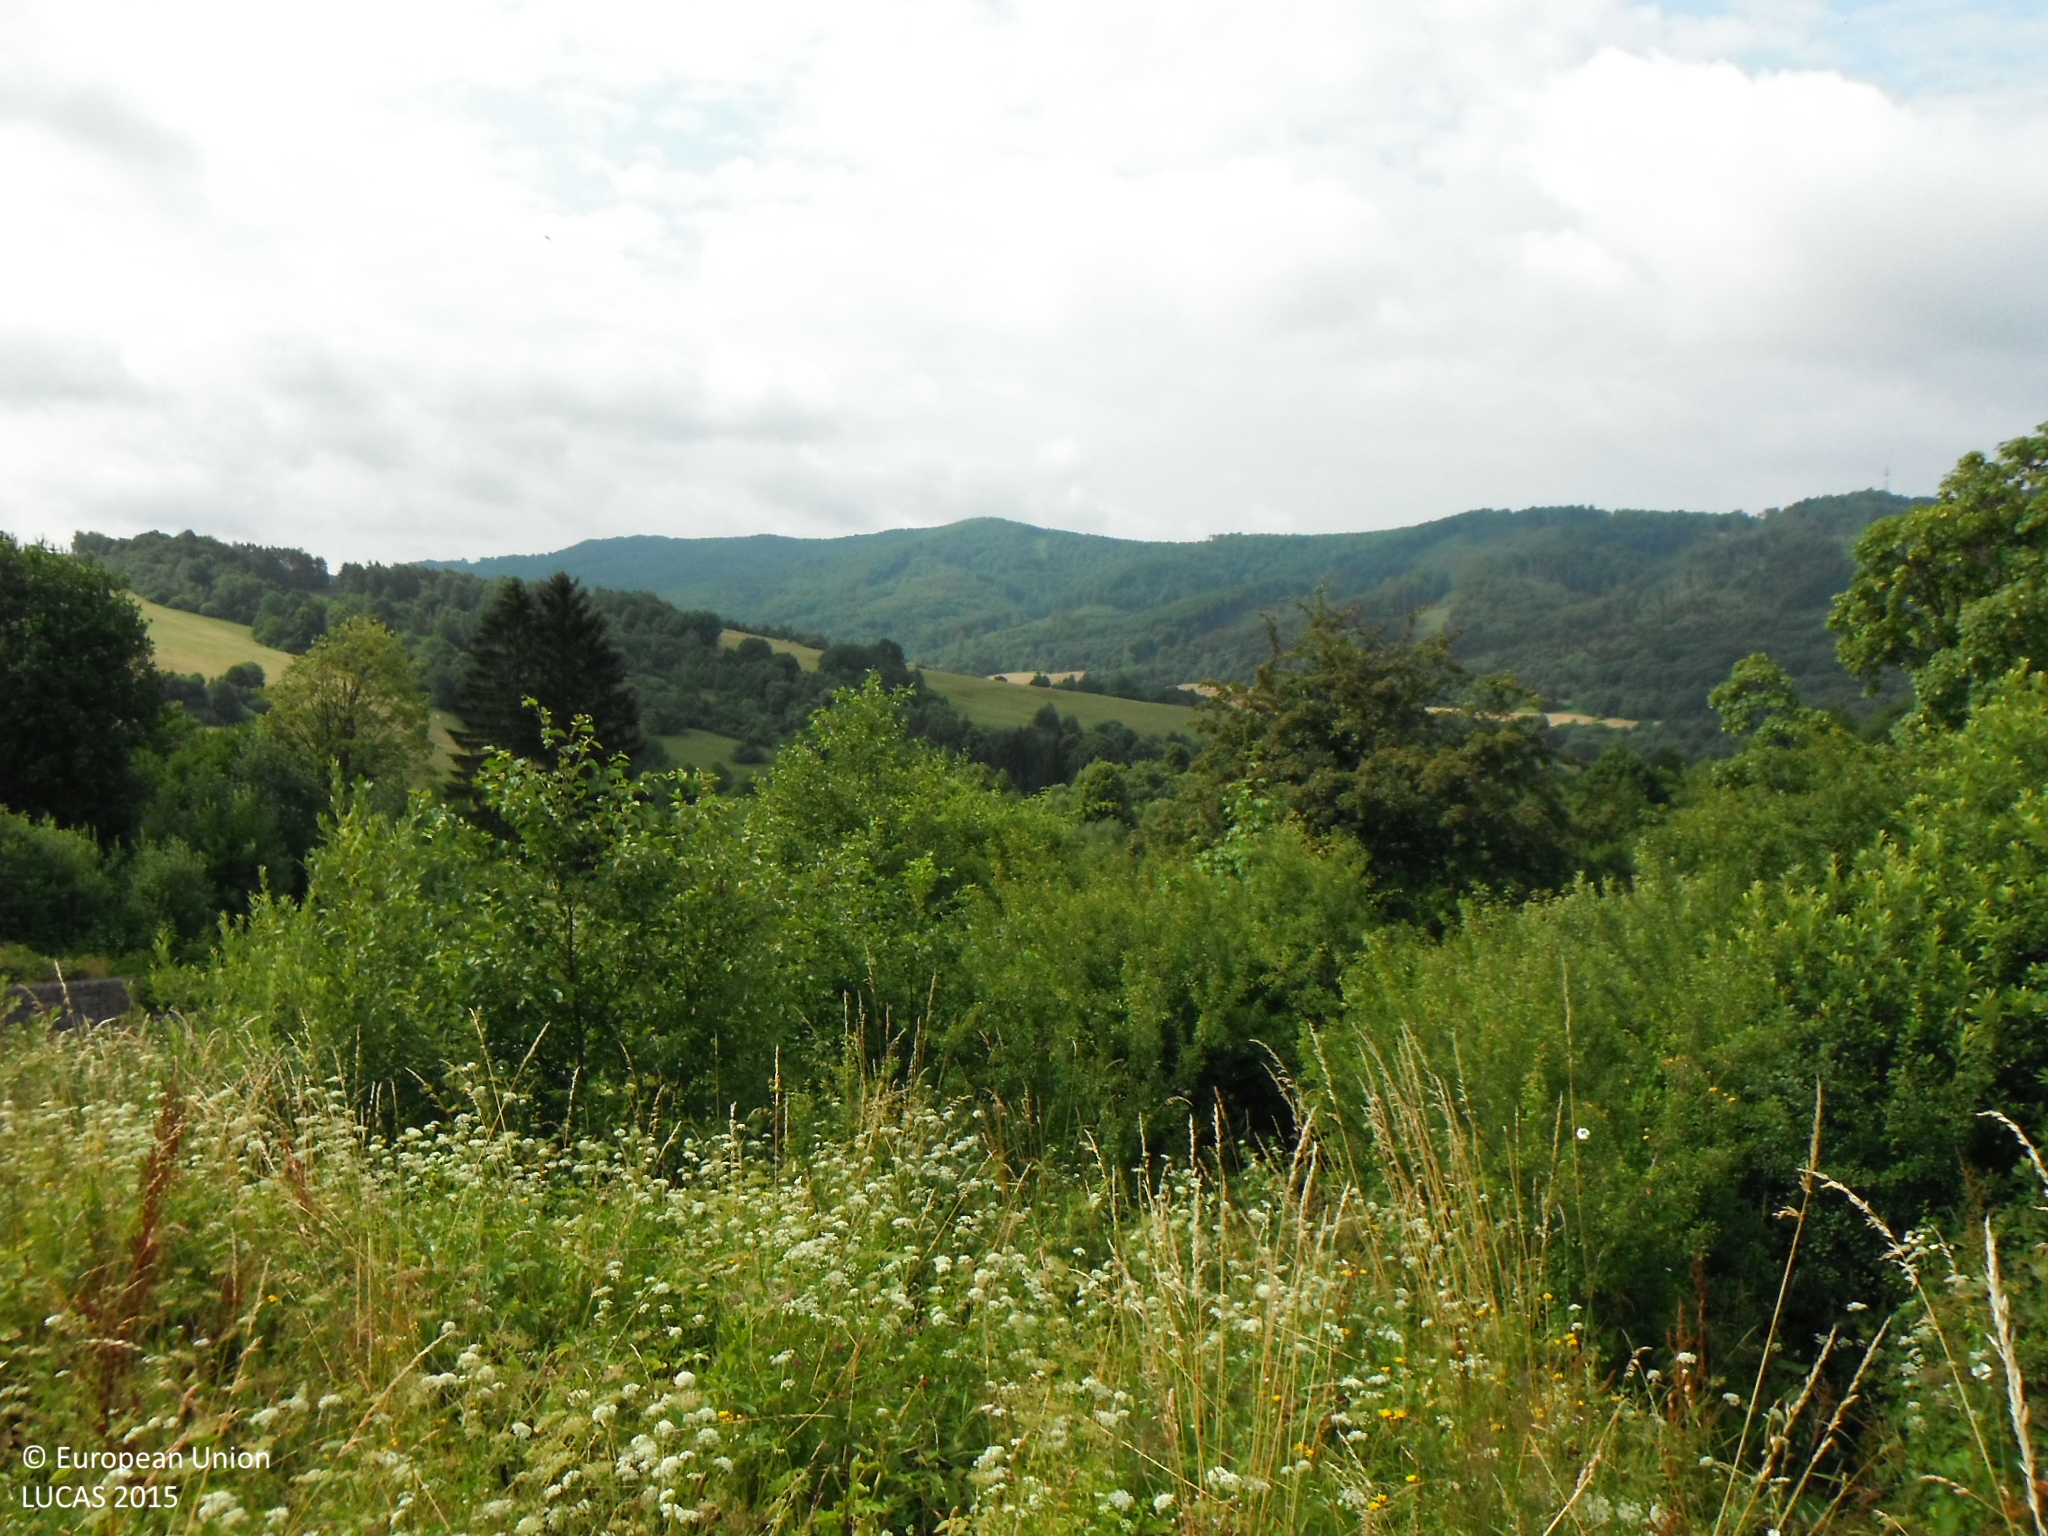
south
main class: Grassland
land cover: Spontaneously vegetated surfaces
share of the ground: > 75 %
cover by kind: herbaceous plants 95 %, shrubs 5 %
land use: Semi-natural and natural areas not in use
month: July
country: SK
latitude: 49.2749
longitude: 22.0004
